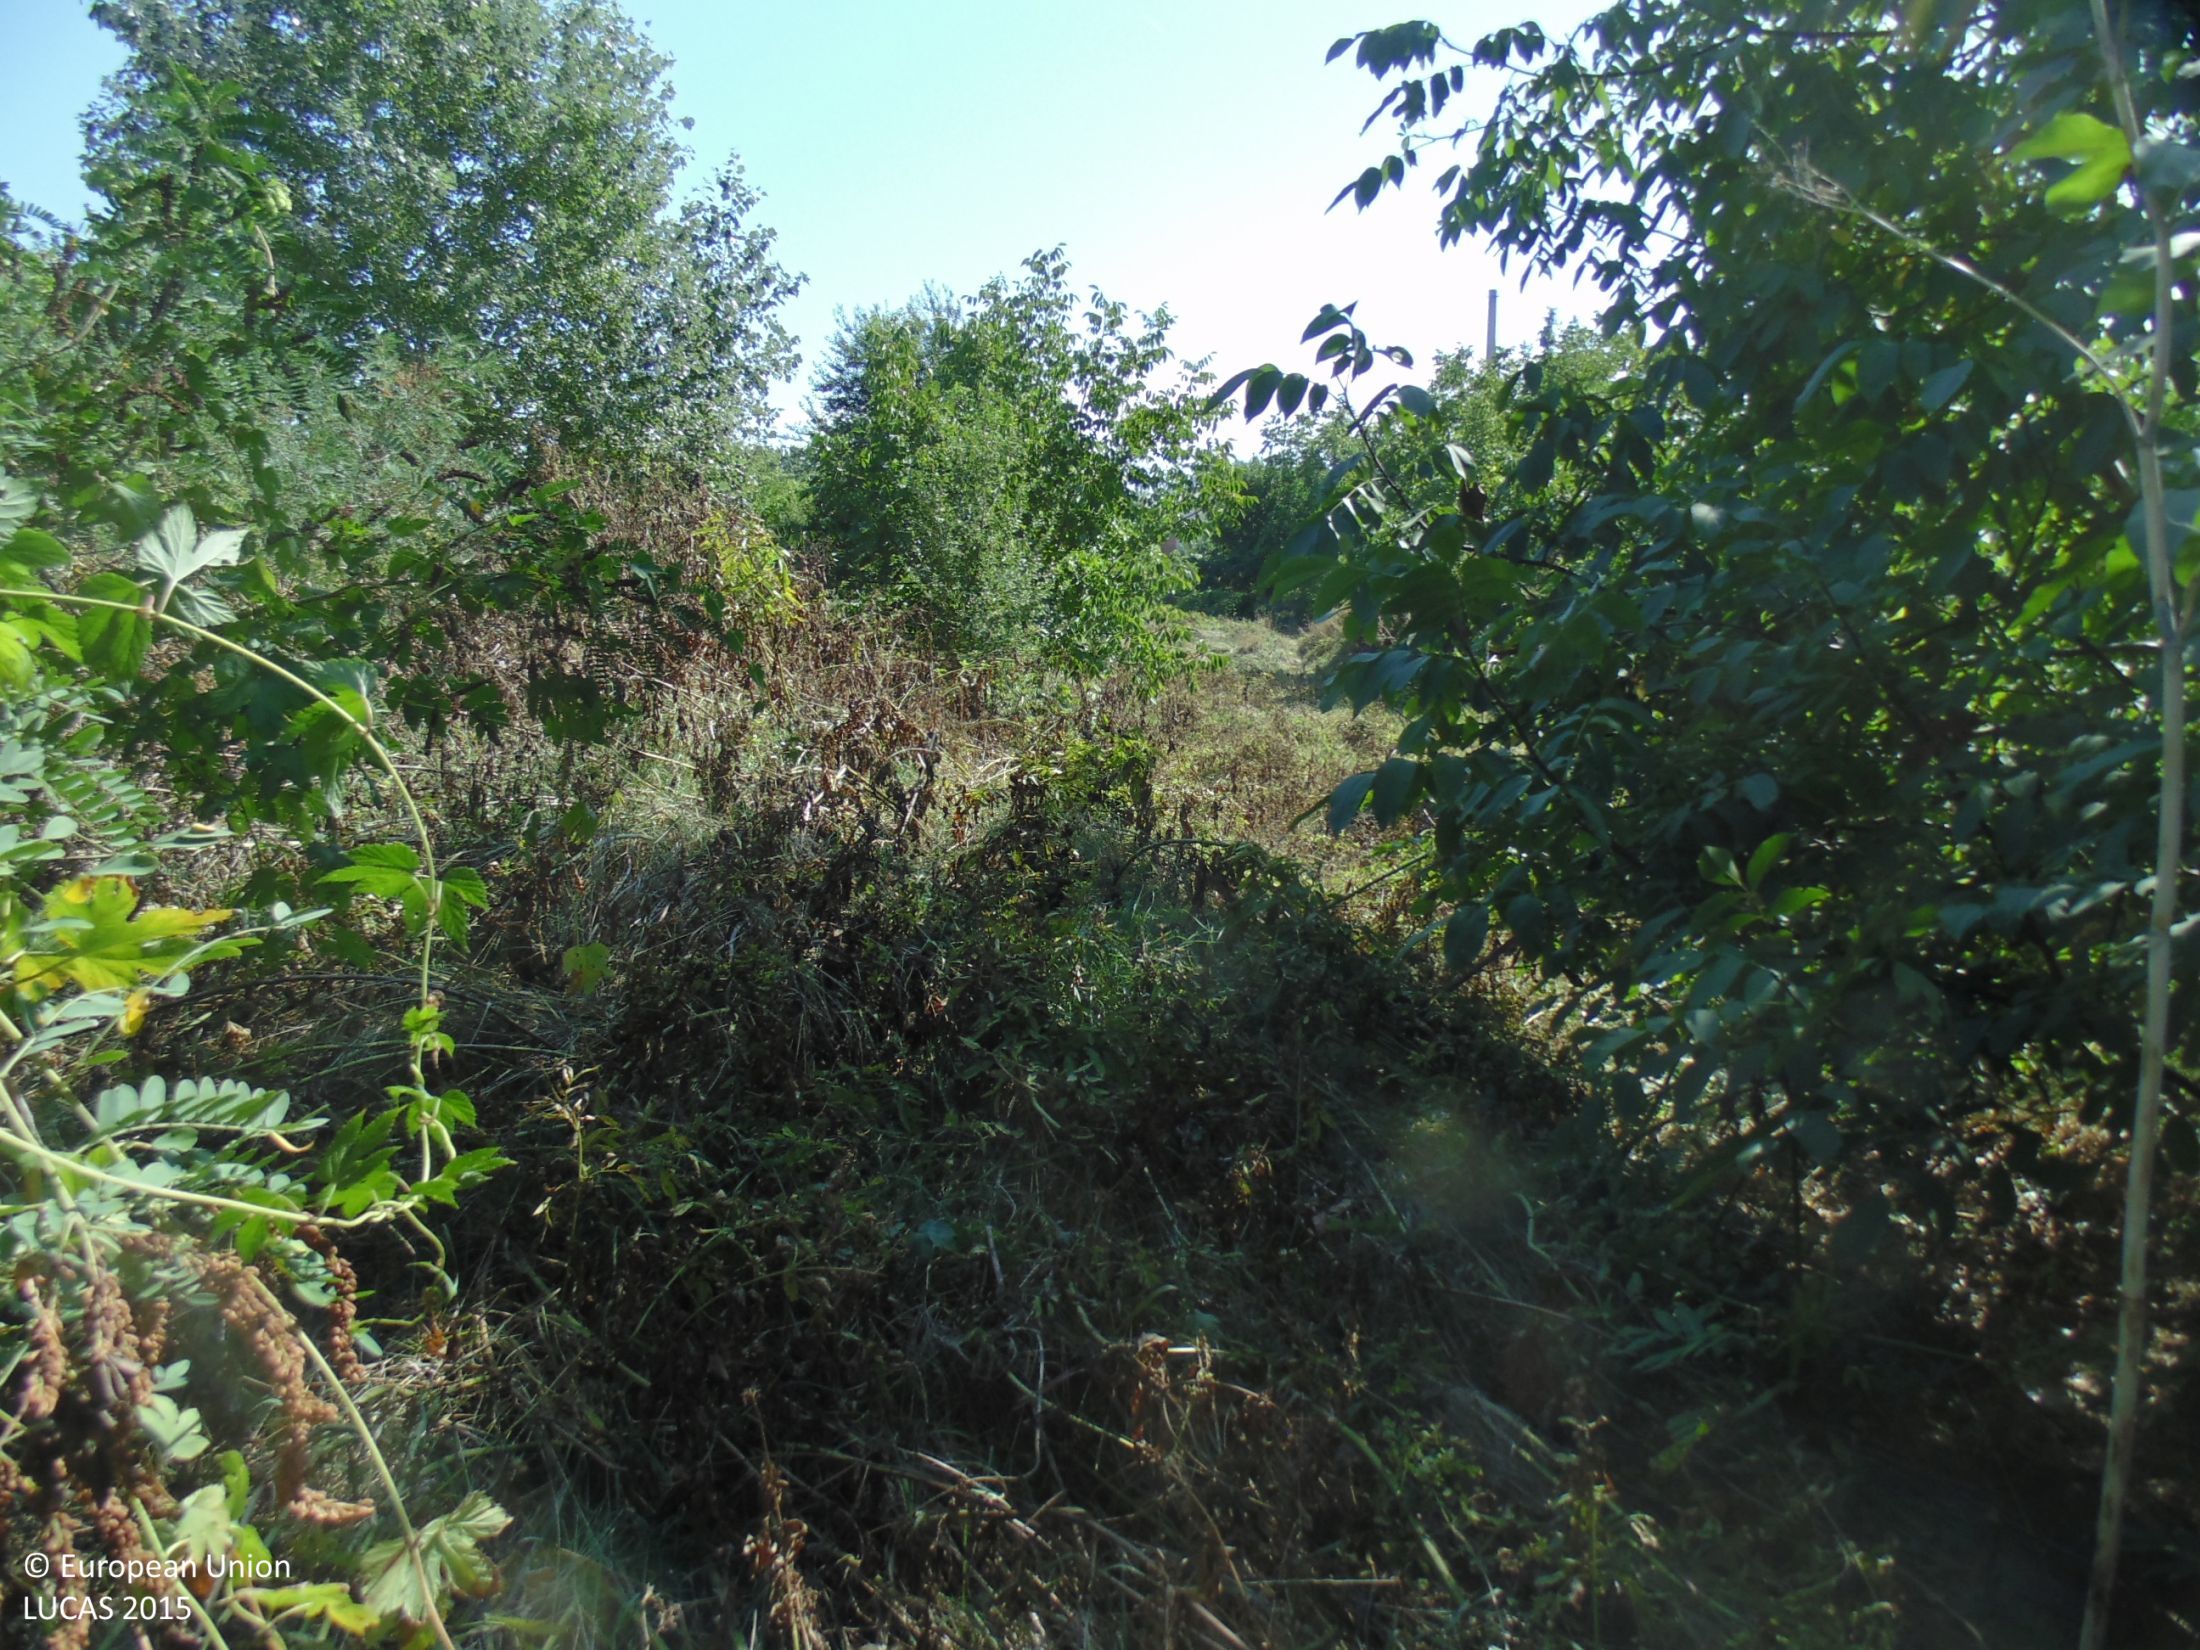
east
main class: Grassland
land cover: Grassland with sparse tree/shrub cover
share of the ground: > 75 %
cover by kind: herbaceous plants 90 %, broadleaved forest trees 5 %, shrubs 5 %
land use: Abandoned areas
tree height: > 5 m
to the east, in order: Grassland with sparse tree/shrub cover; Grass margins; Railways; Grassland with sparse tree/shrub cover; Railways; Grass margins; Broadleaved woodland
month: September
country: BG
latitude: 44.1102
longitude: 27.2353
